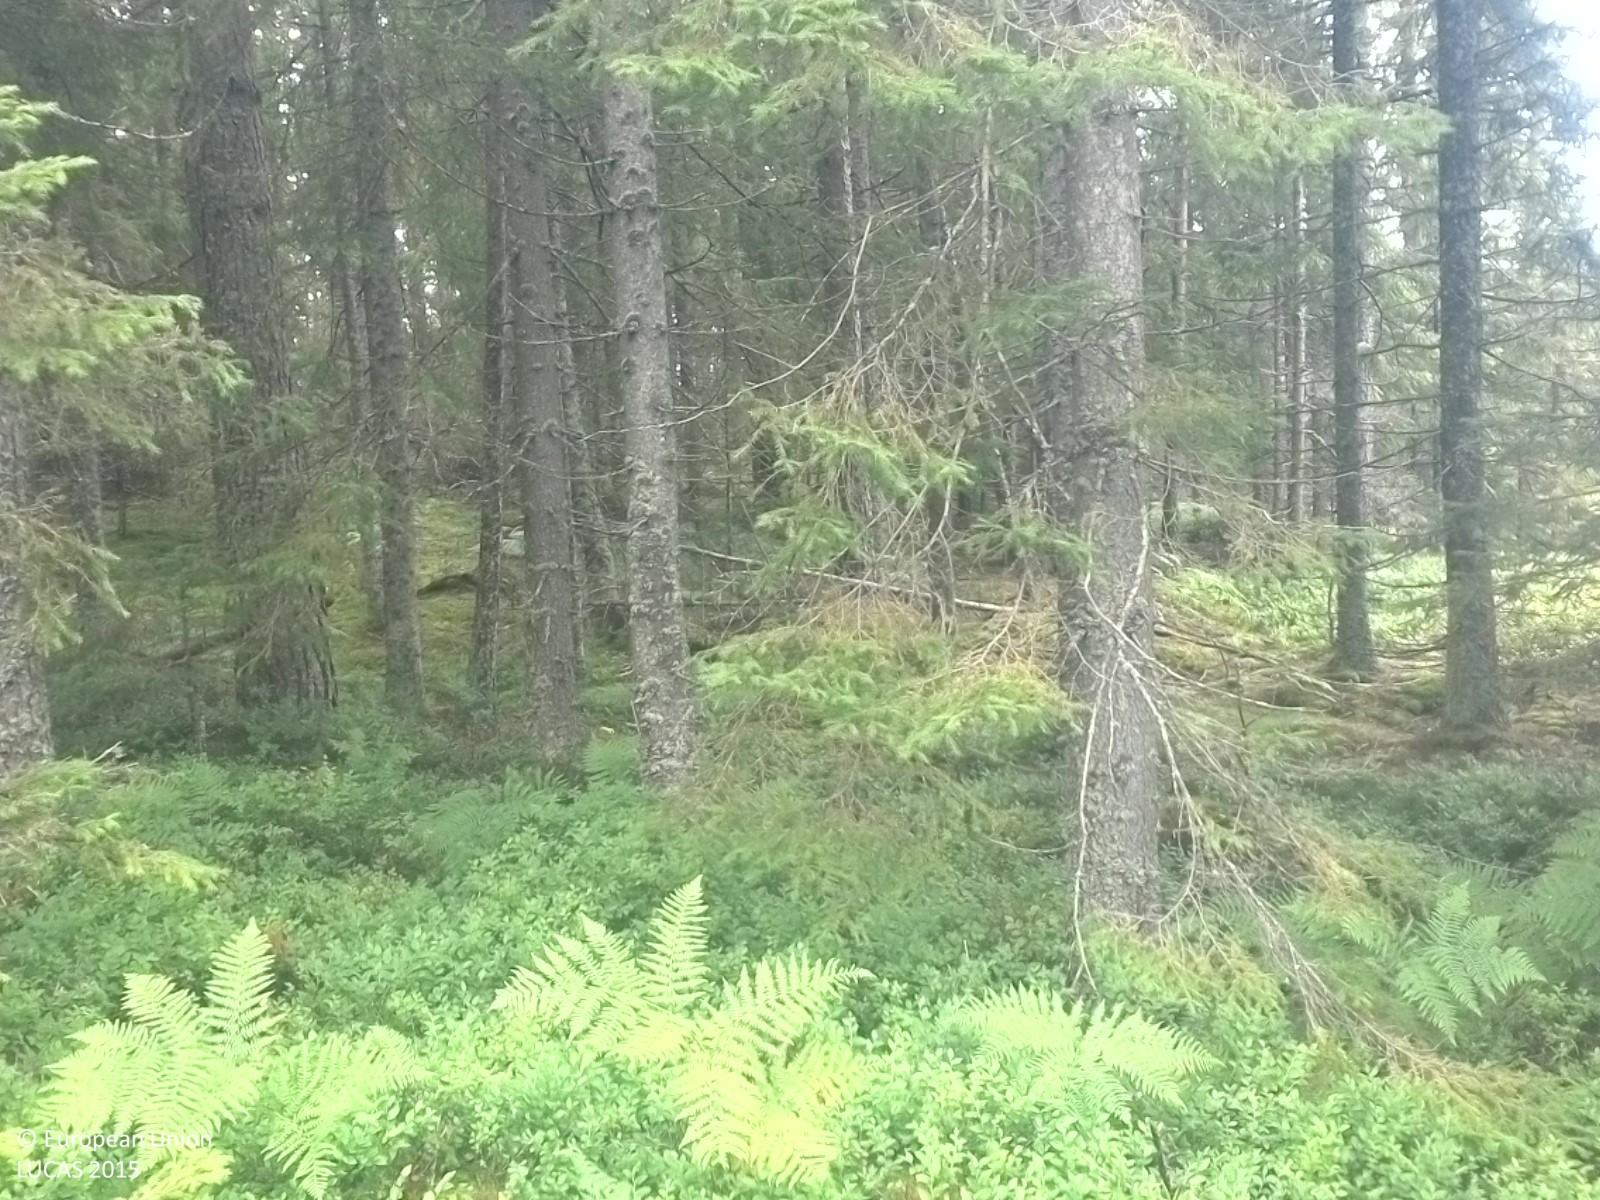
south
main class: Woodland
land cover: Other coniferous woodland
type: boreal forest
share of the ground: 10 - 25 %
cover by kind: herbaceous plants 50 %, coniferous forest trees 20 %, shrubs 20 %, lichens and mosses 10 %
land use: Forestry
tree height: < 5 m
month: July
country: SE
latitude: 58.9860
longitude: 15.1603
